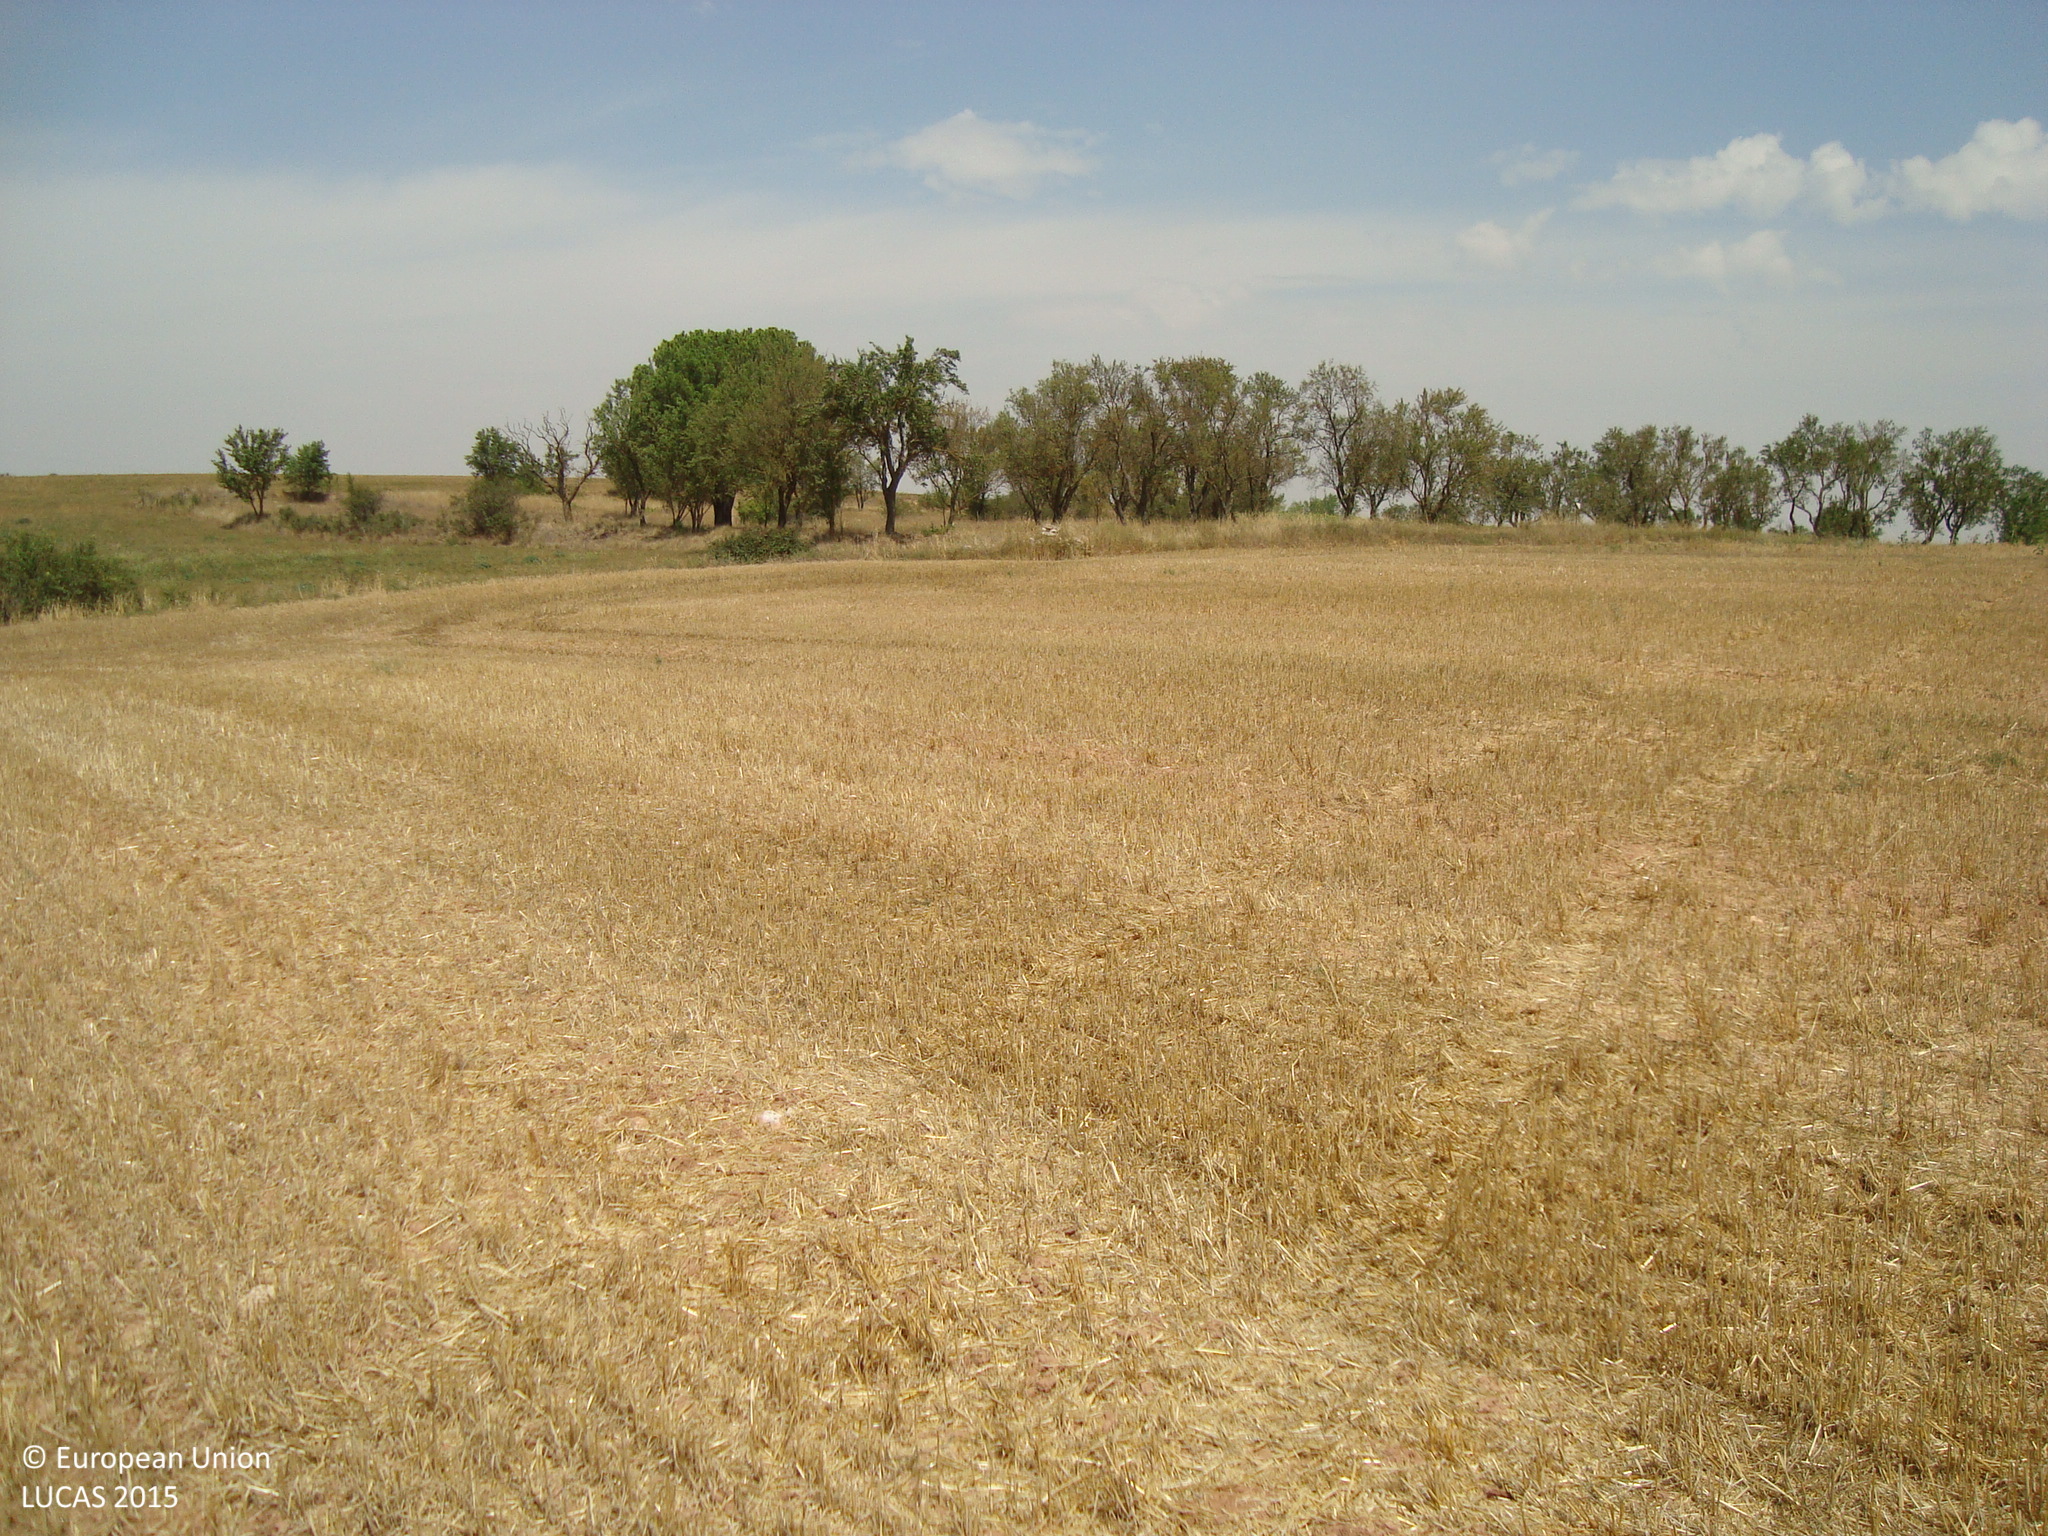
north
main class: Cropland
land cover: Common wheat
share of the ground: > 75 %
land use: Agriculture (excluding fallow land and kitchen gardens)
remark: Harvested field
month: August
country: ES
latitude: 42.1388
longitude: -3.9642
